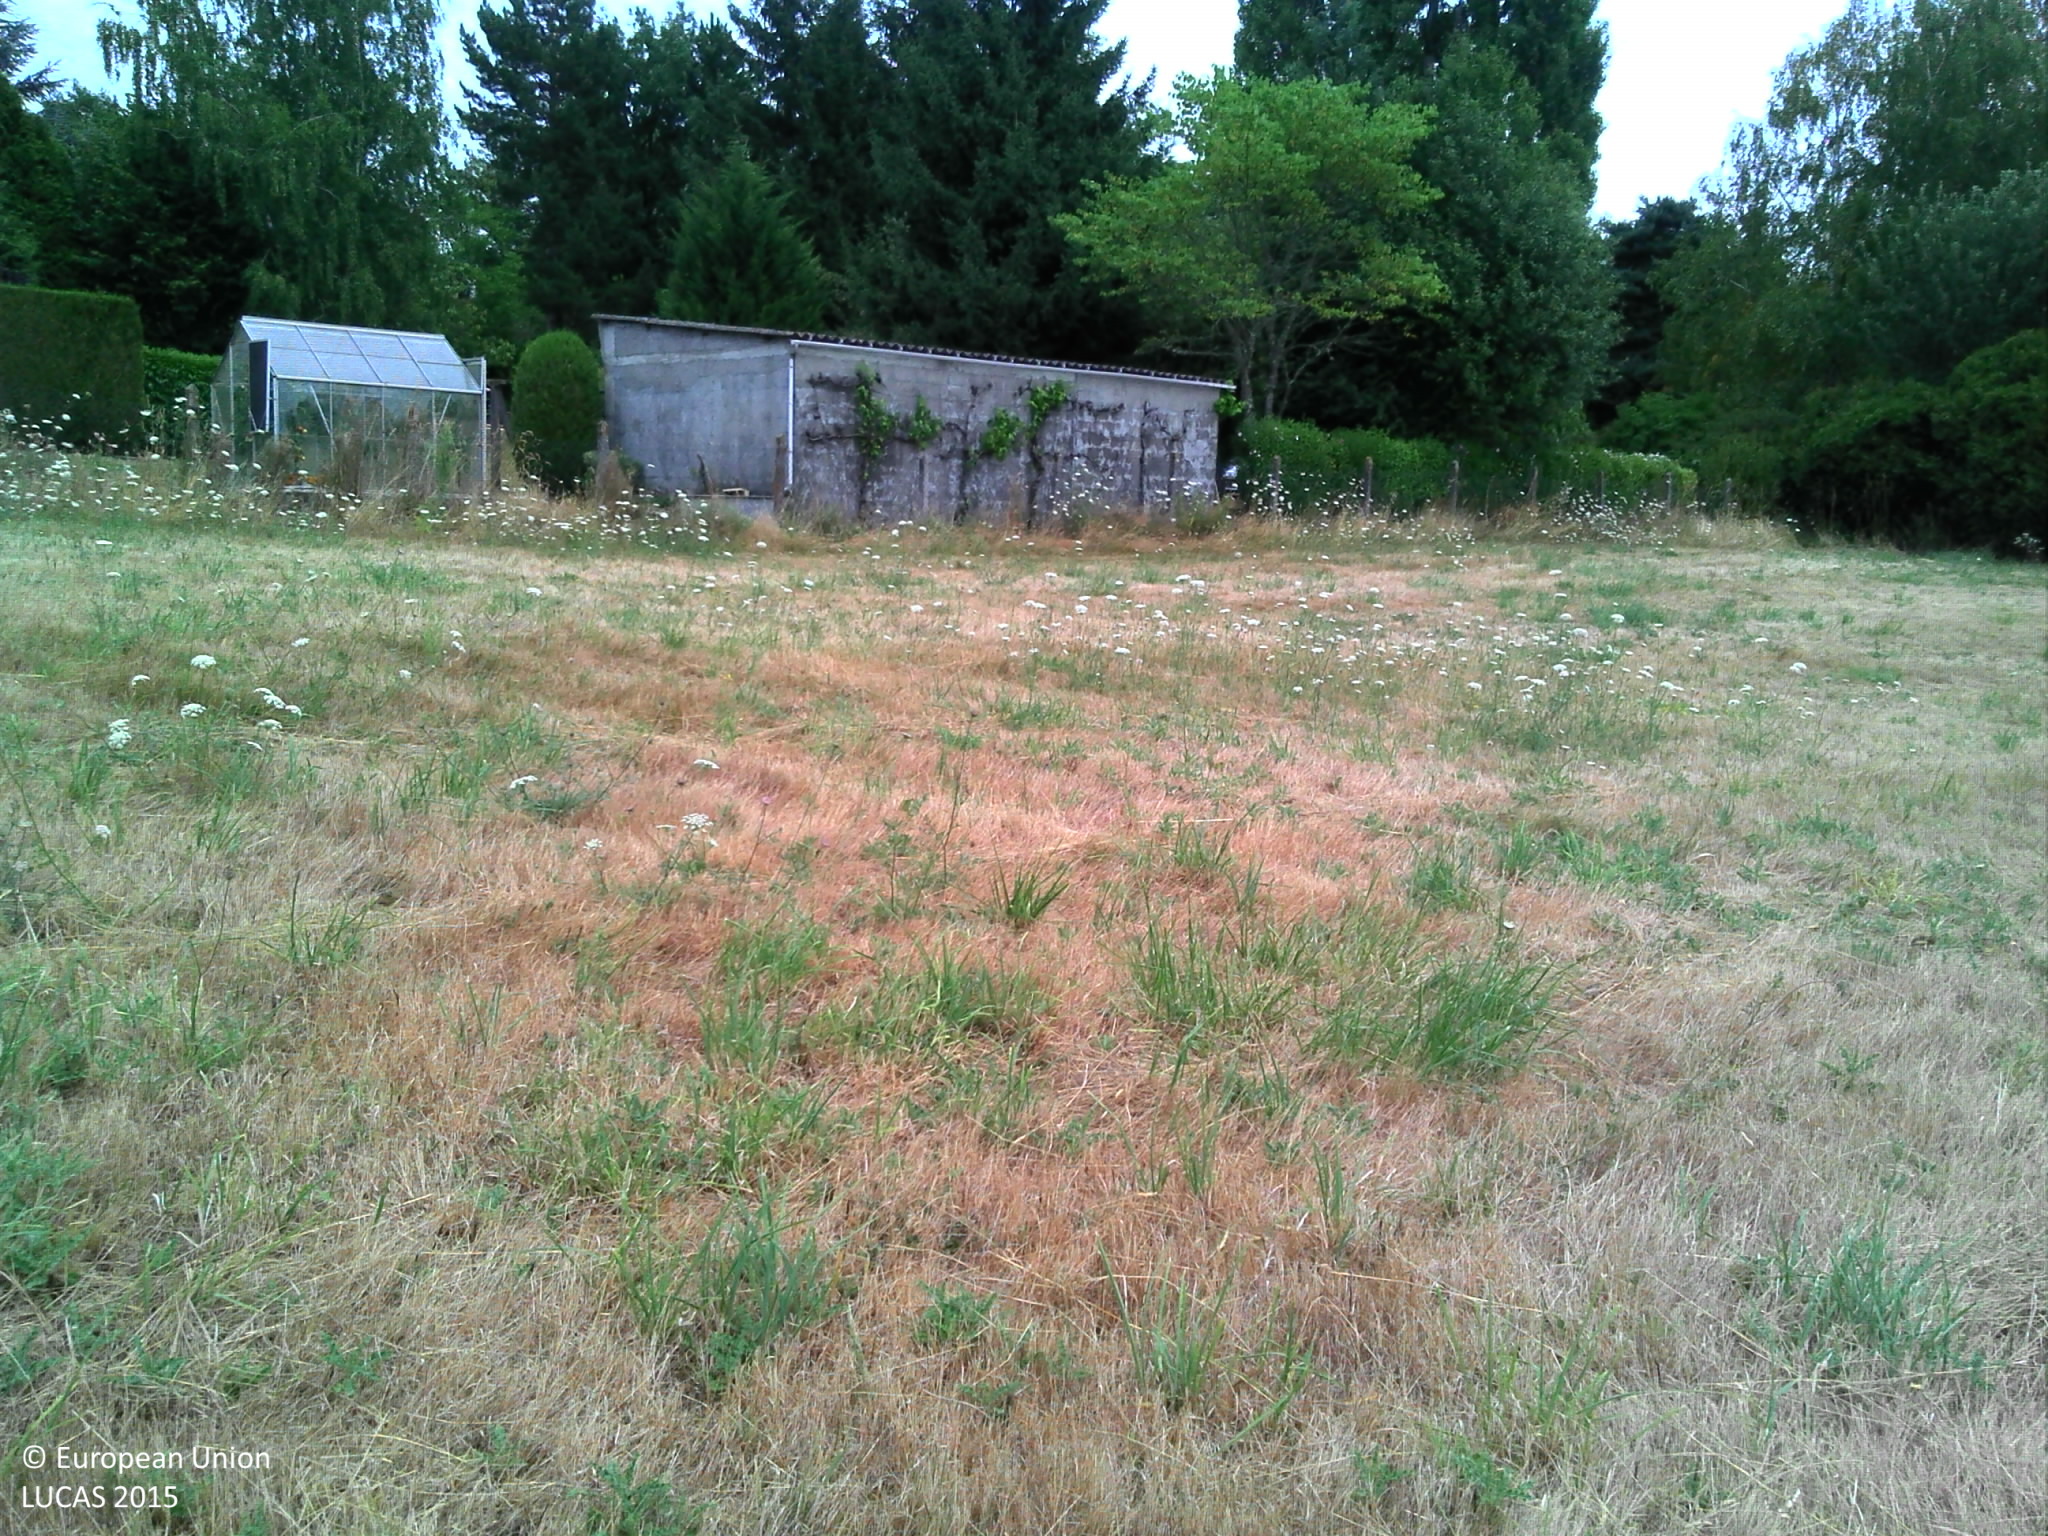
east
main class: Grassland
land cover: Grassland without tree/shrub cover
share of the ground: > 75 %
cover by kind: herbaceous plants 95 %, shrubs 5 %
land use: Agriculture (excluding fallow land and kitchen gardens)
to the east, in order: Grassland without tree/shrub cover; Artificial constructions in urban areas
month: July
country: FR
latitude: 45.8948
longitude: 0.9540
